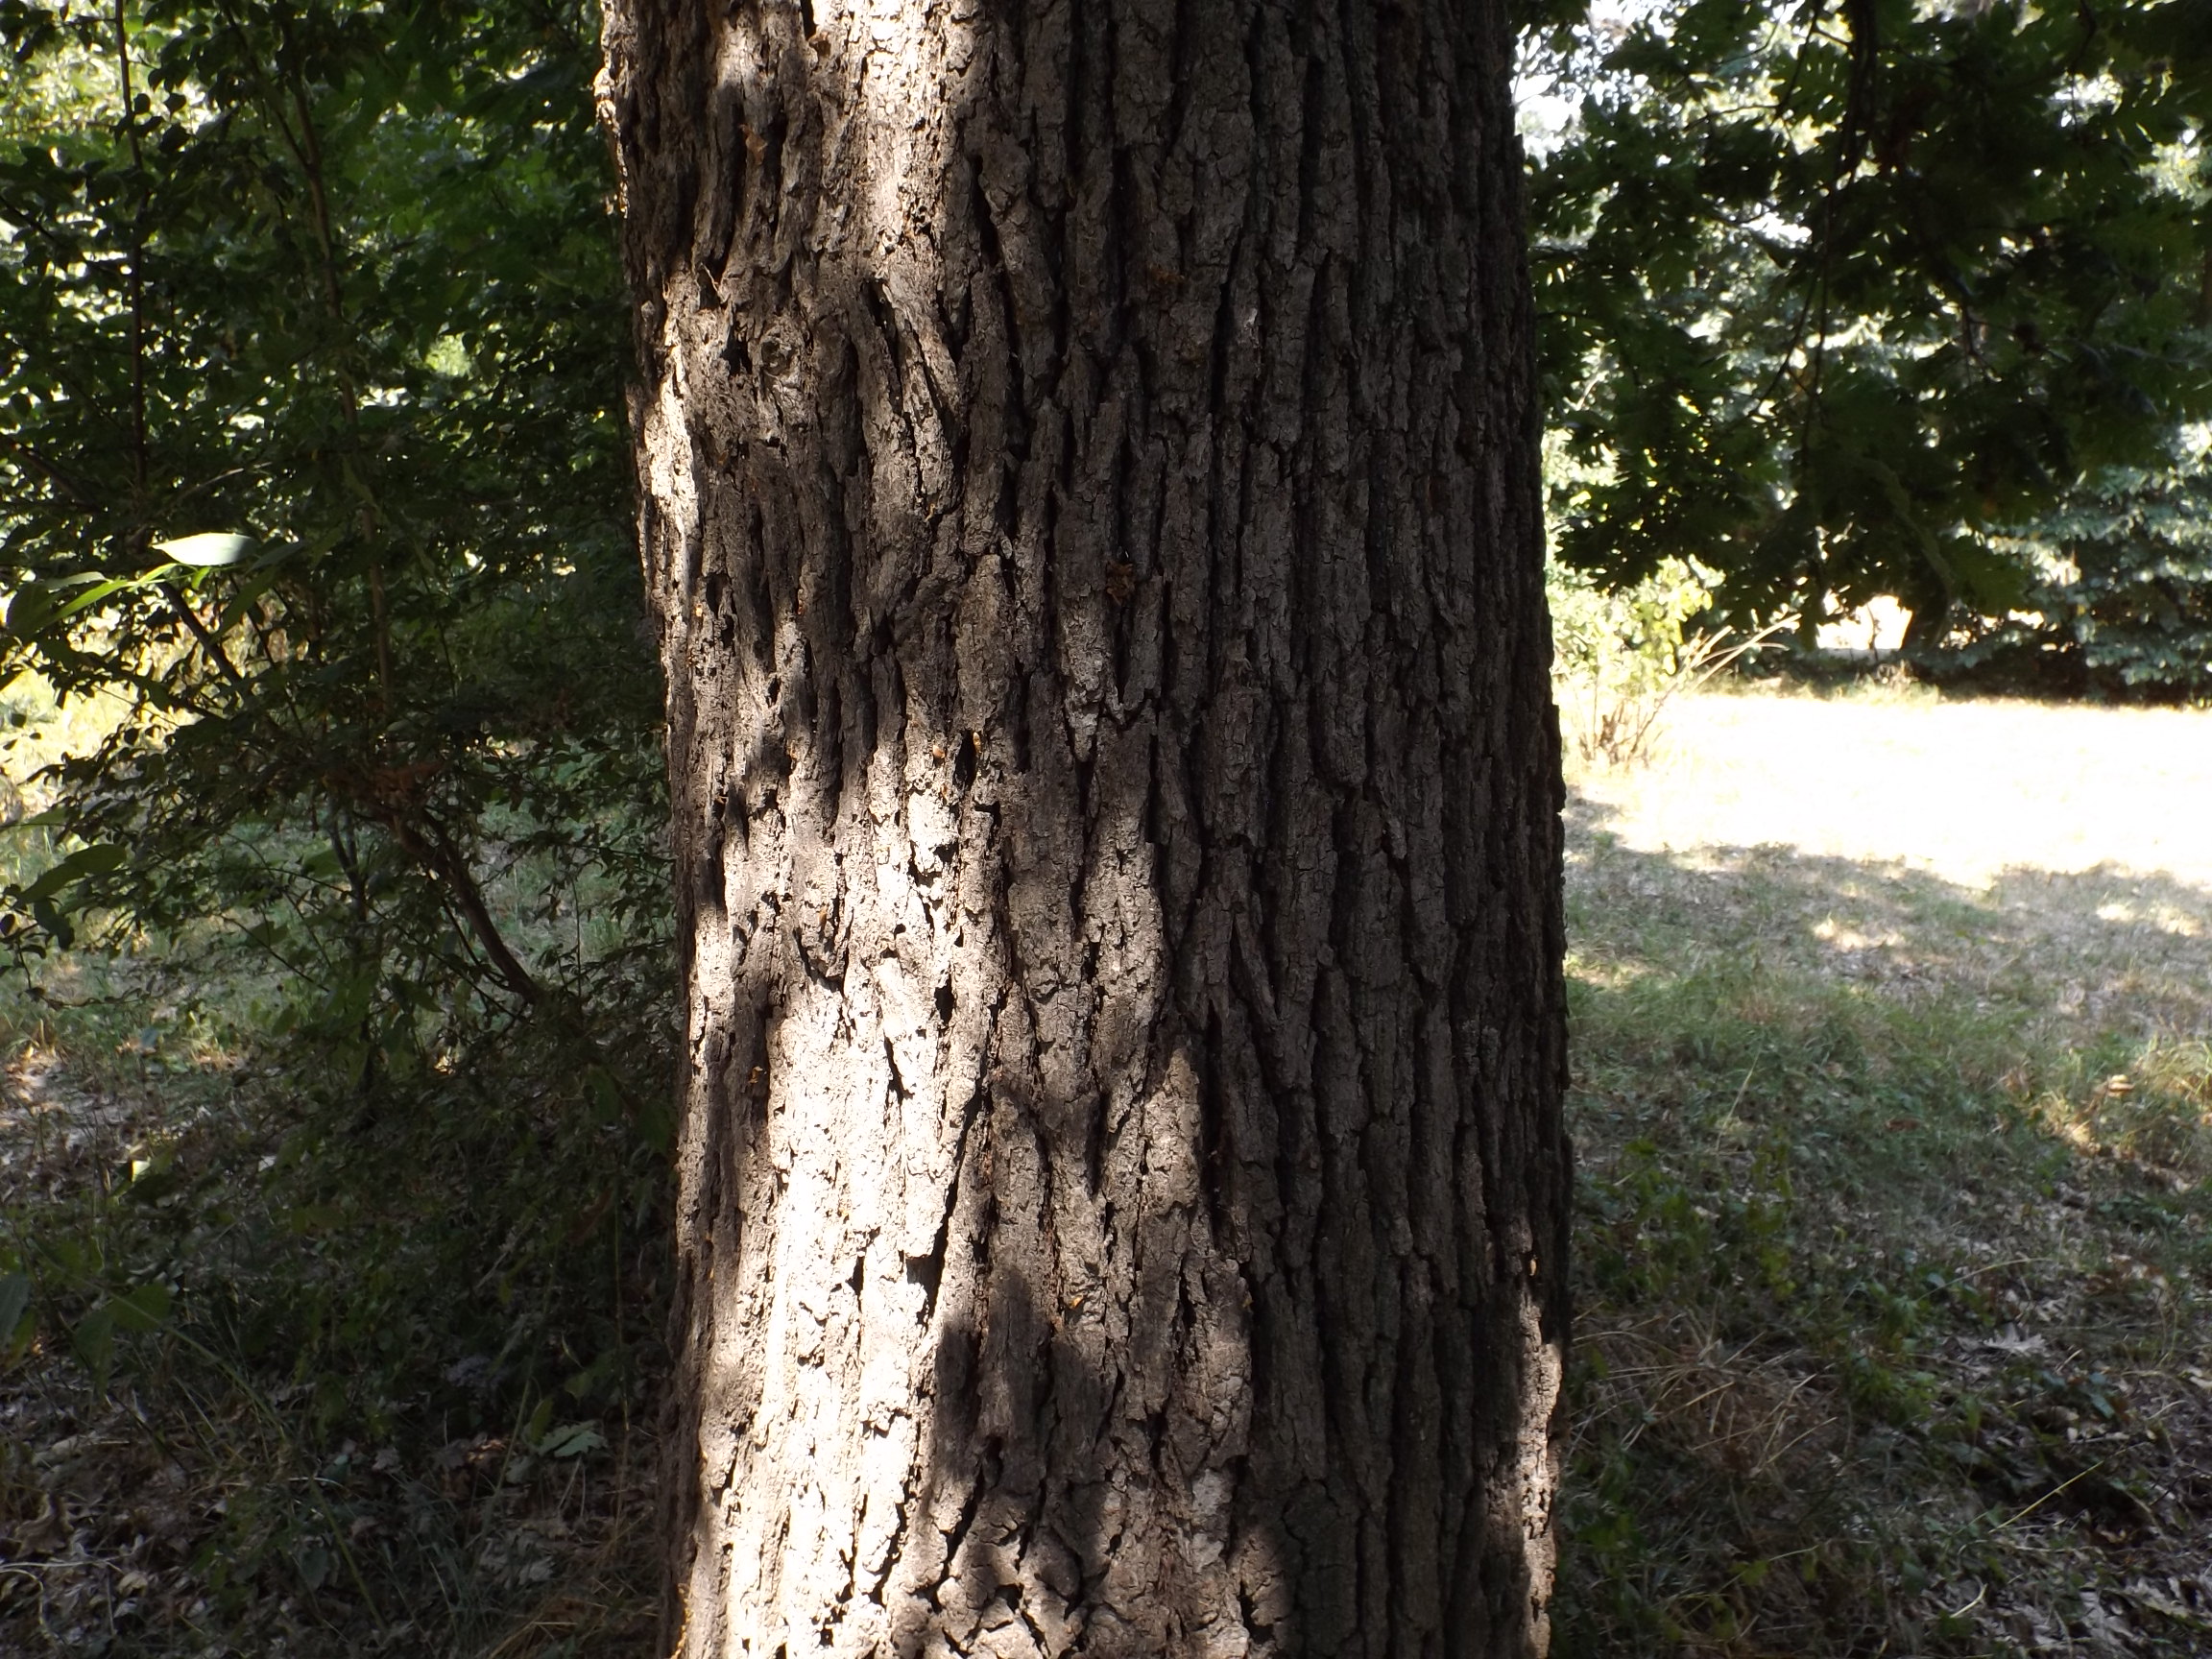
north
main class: Woodland
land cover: Broadleaved woodland
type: thermophilous deciduous forest
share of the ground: > 75 %
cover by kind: broadleaved forest trees 80 %, herbaceous plants 15 %, shrubs 5 %
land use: Forestry
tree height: > 5 m
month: July
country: BG
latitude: 43.4106
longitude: 27.5563
